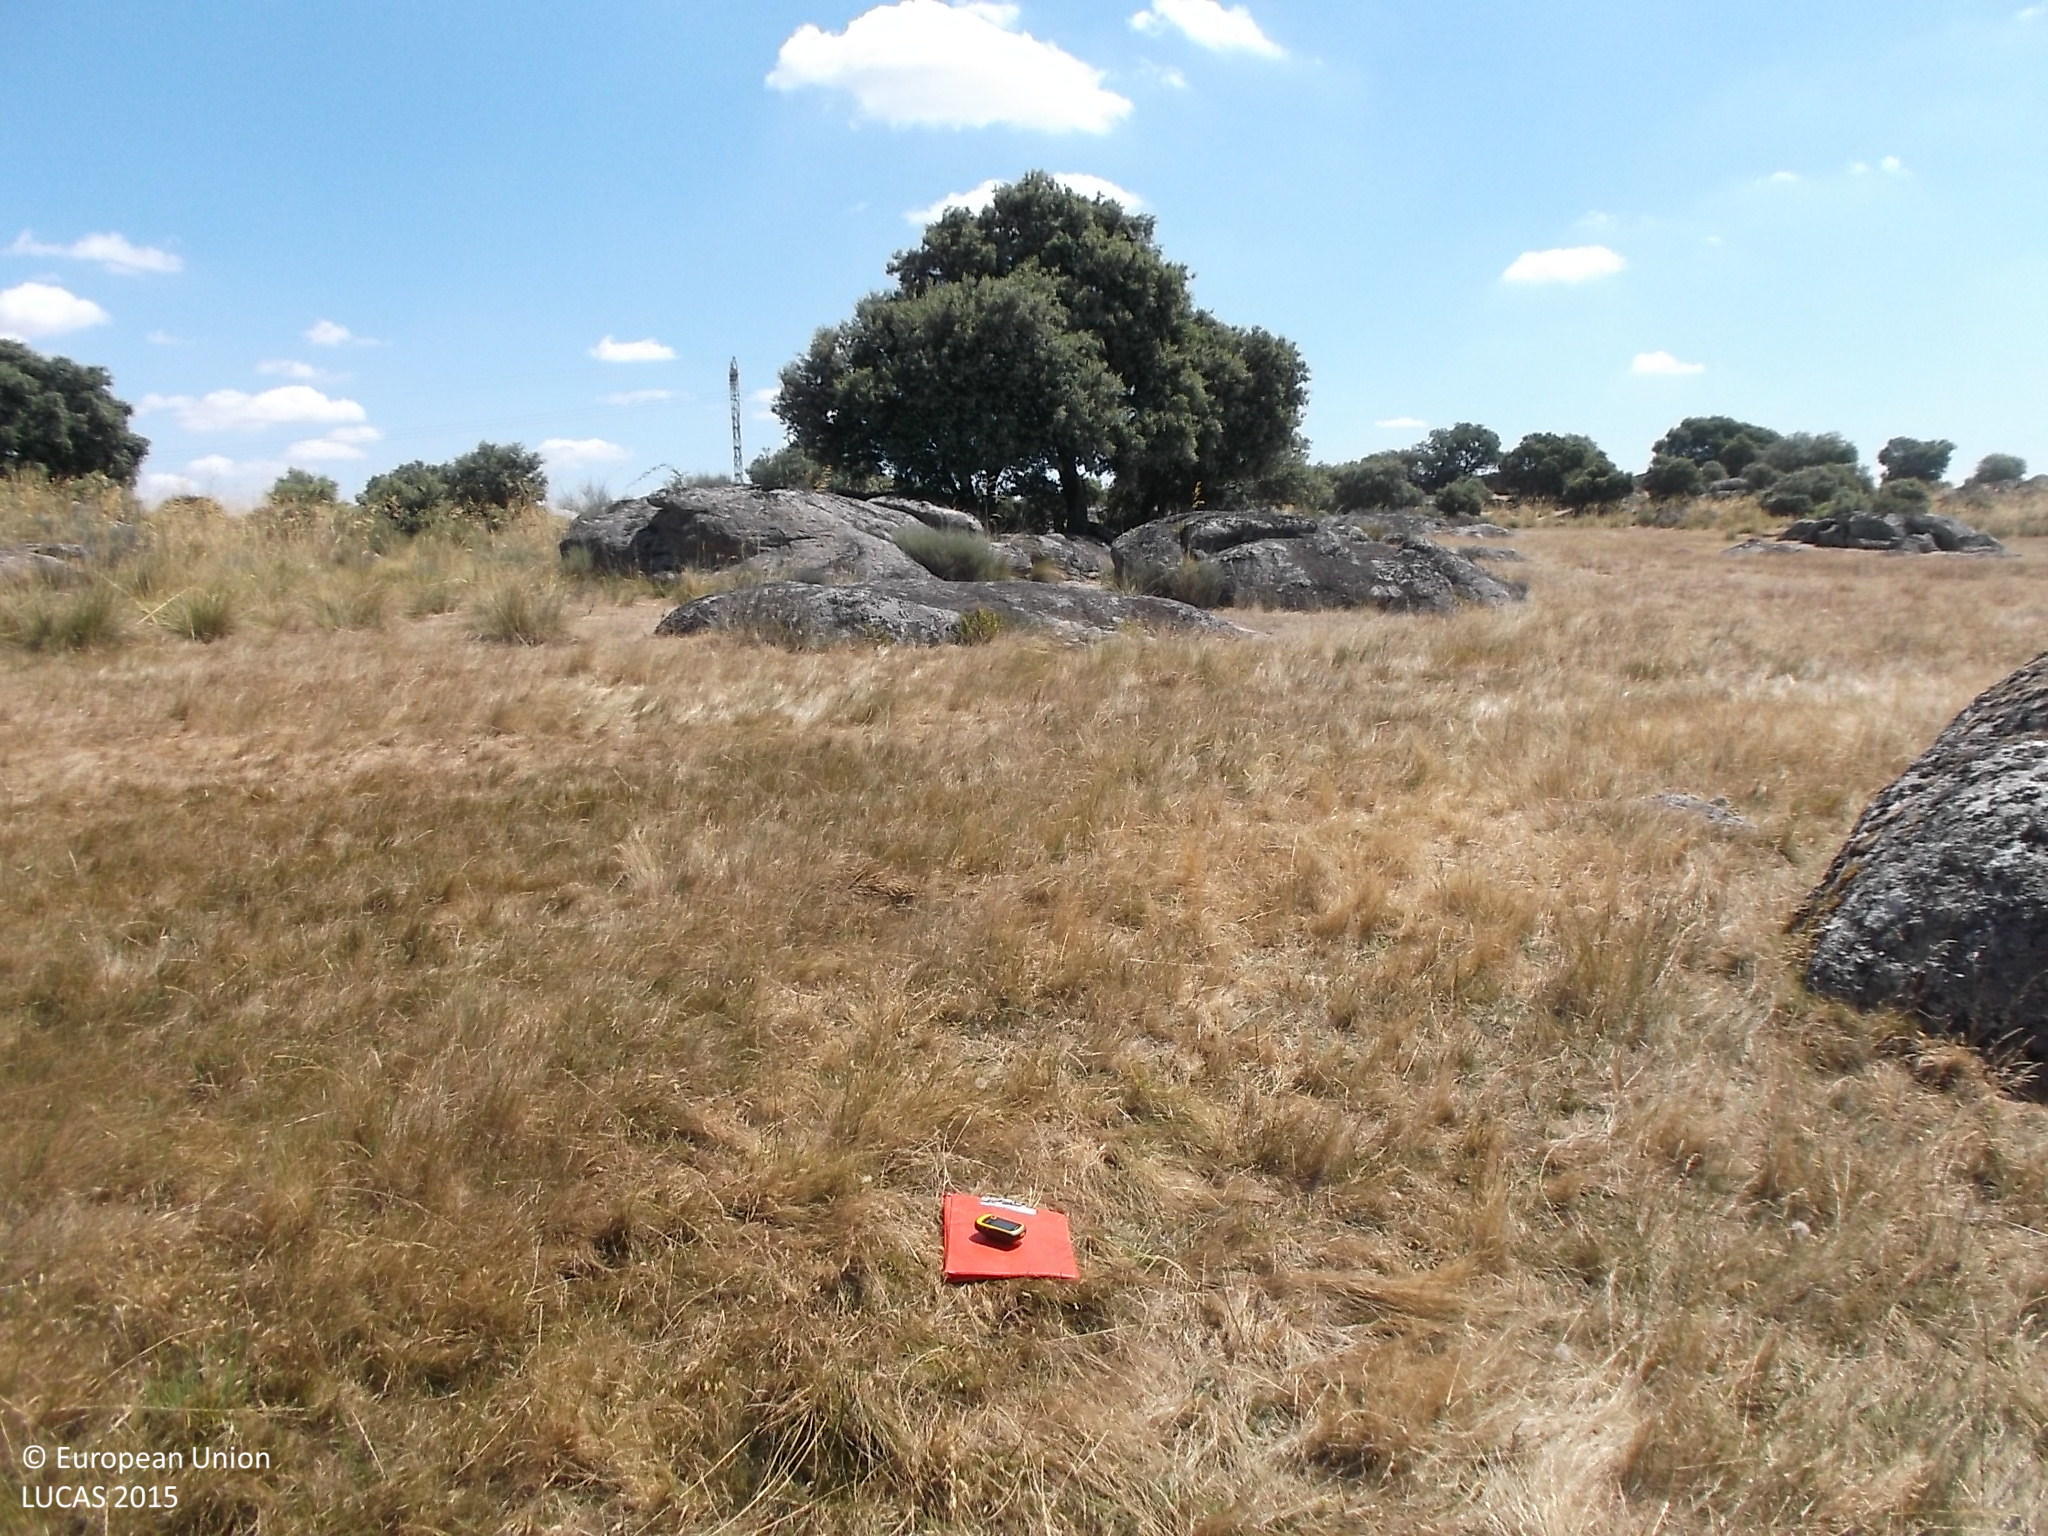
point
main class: Grassland
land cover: Grassland without tree/shrub cover
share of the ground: > 75 %
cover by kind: herbaceous plants 100 %
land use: Agriculture (excluding fallow land and kitchen gardens)
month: July
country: ES
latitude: 41.4210
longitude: -6.0407
